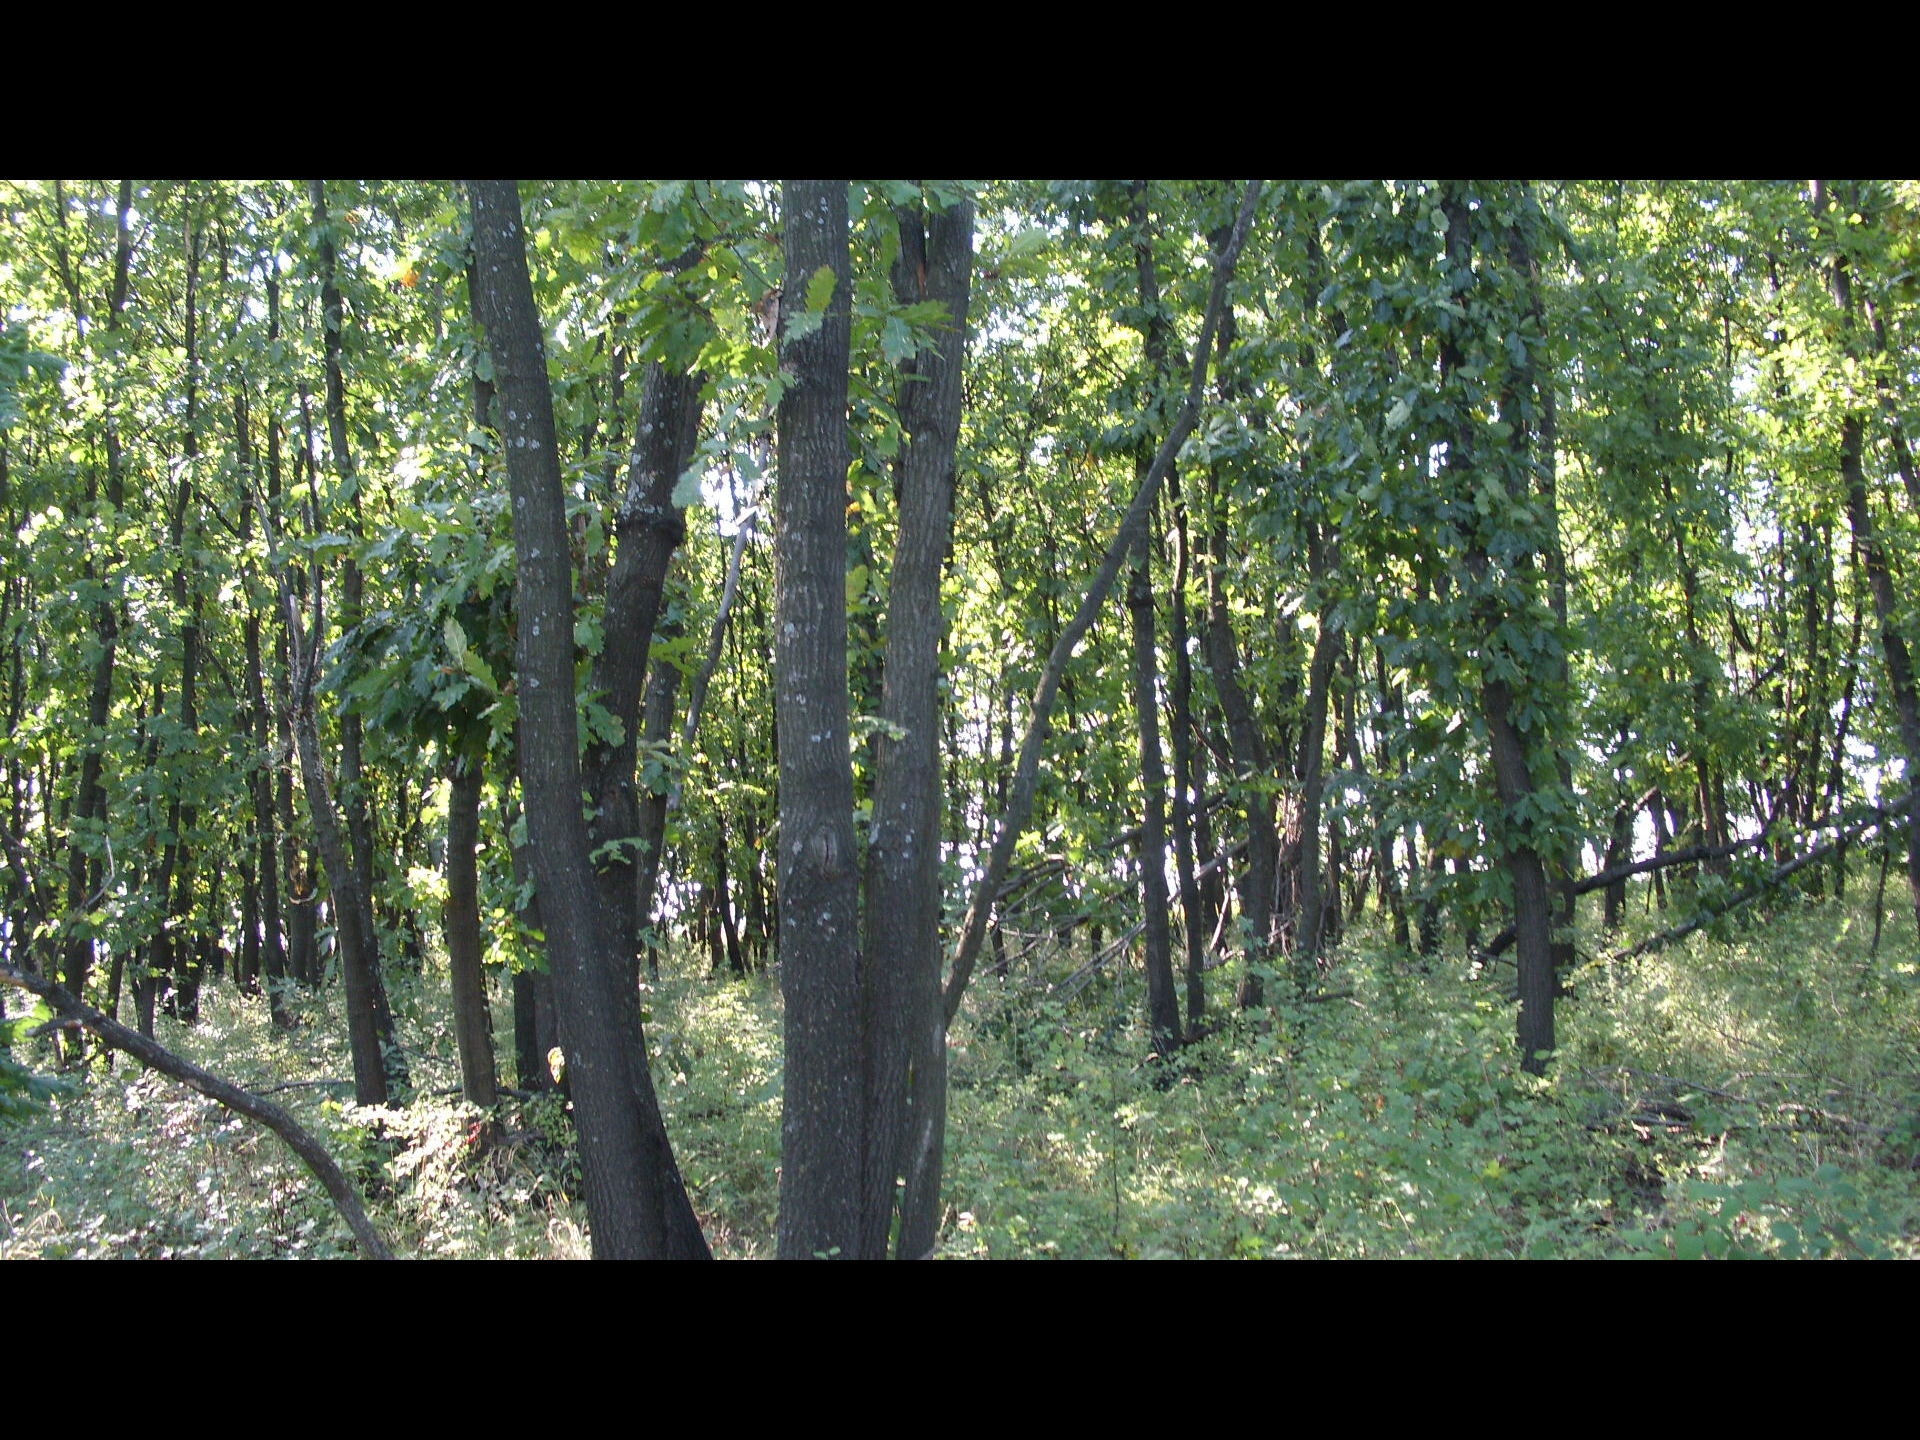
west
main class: Woodland
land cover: Broadleaved woodland
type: mesophytic deciduous forest
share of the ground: > 75 %
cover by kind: broadleaved forest trees 85 %, herbaceous plants 15 %
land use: Forestry
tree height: > 5 m
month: October
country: BG
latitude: 43.8693
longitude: 22.4641
